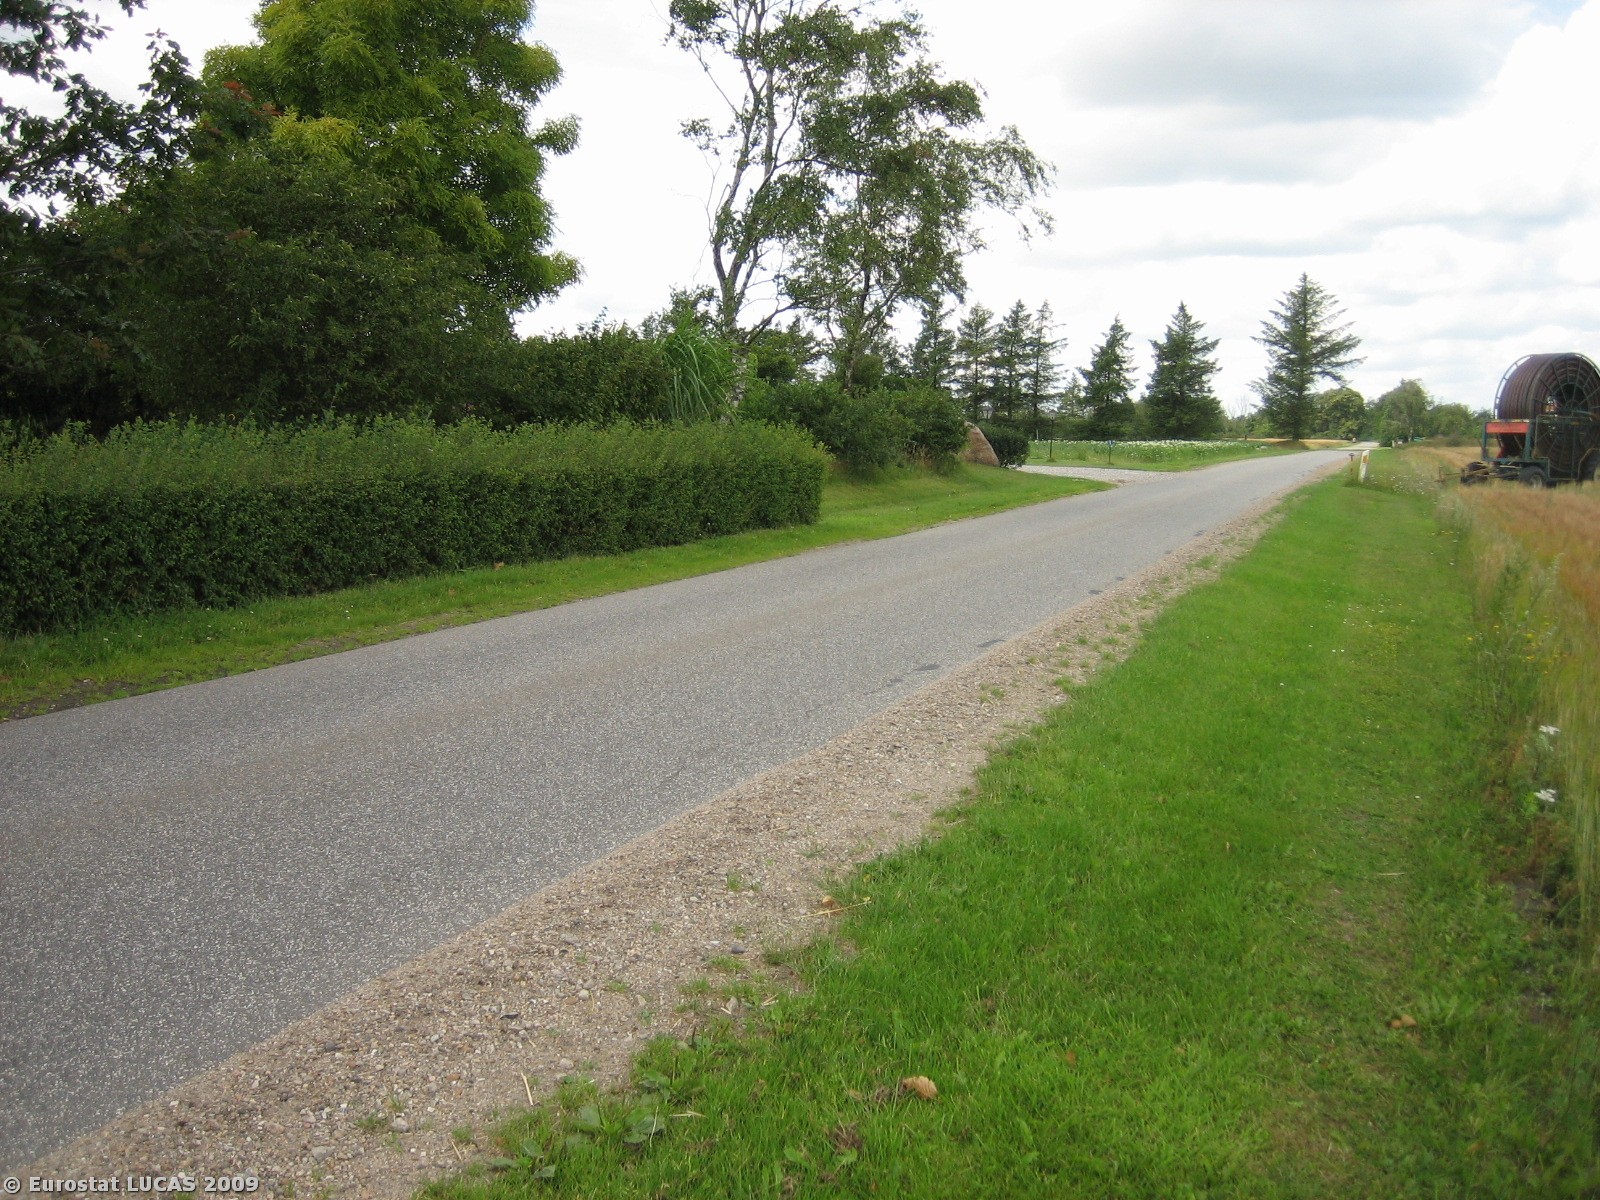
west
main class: Cropland
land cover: Barley
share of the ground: > 75 %
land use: Agriculture (excluding fallow land and kitchen gardens)
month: July
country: DK
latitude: 55.7883
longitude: 8.9963
